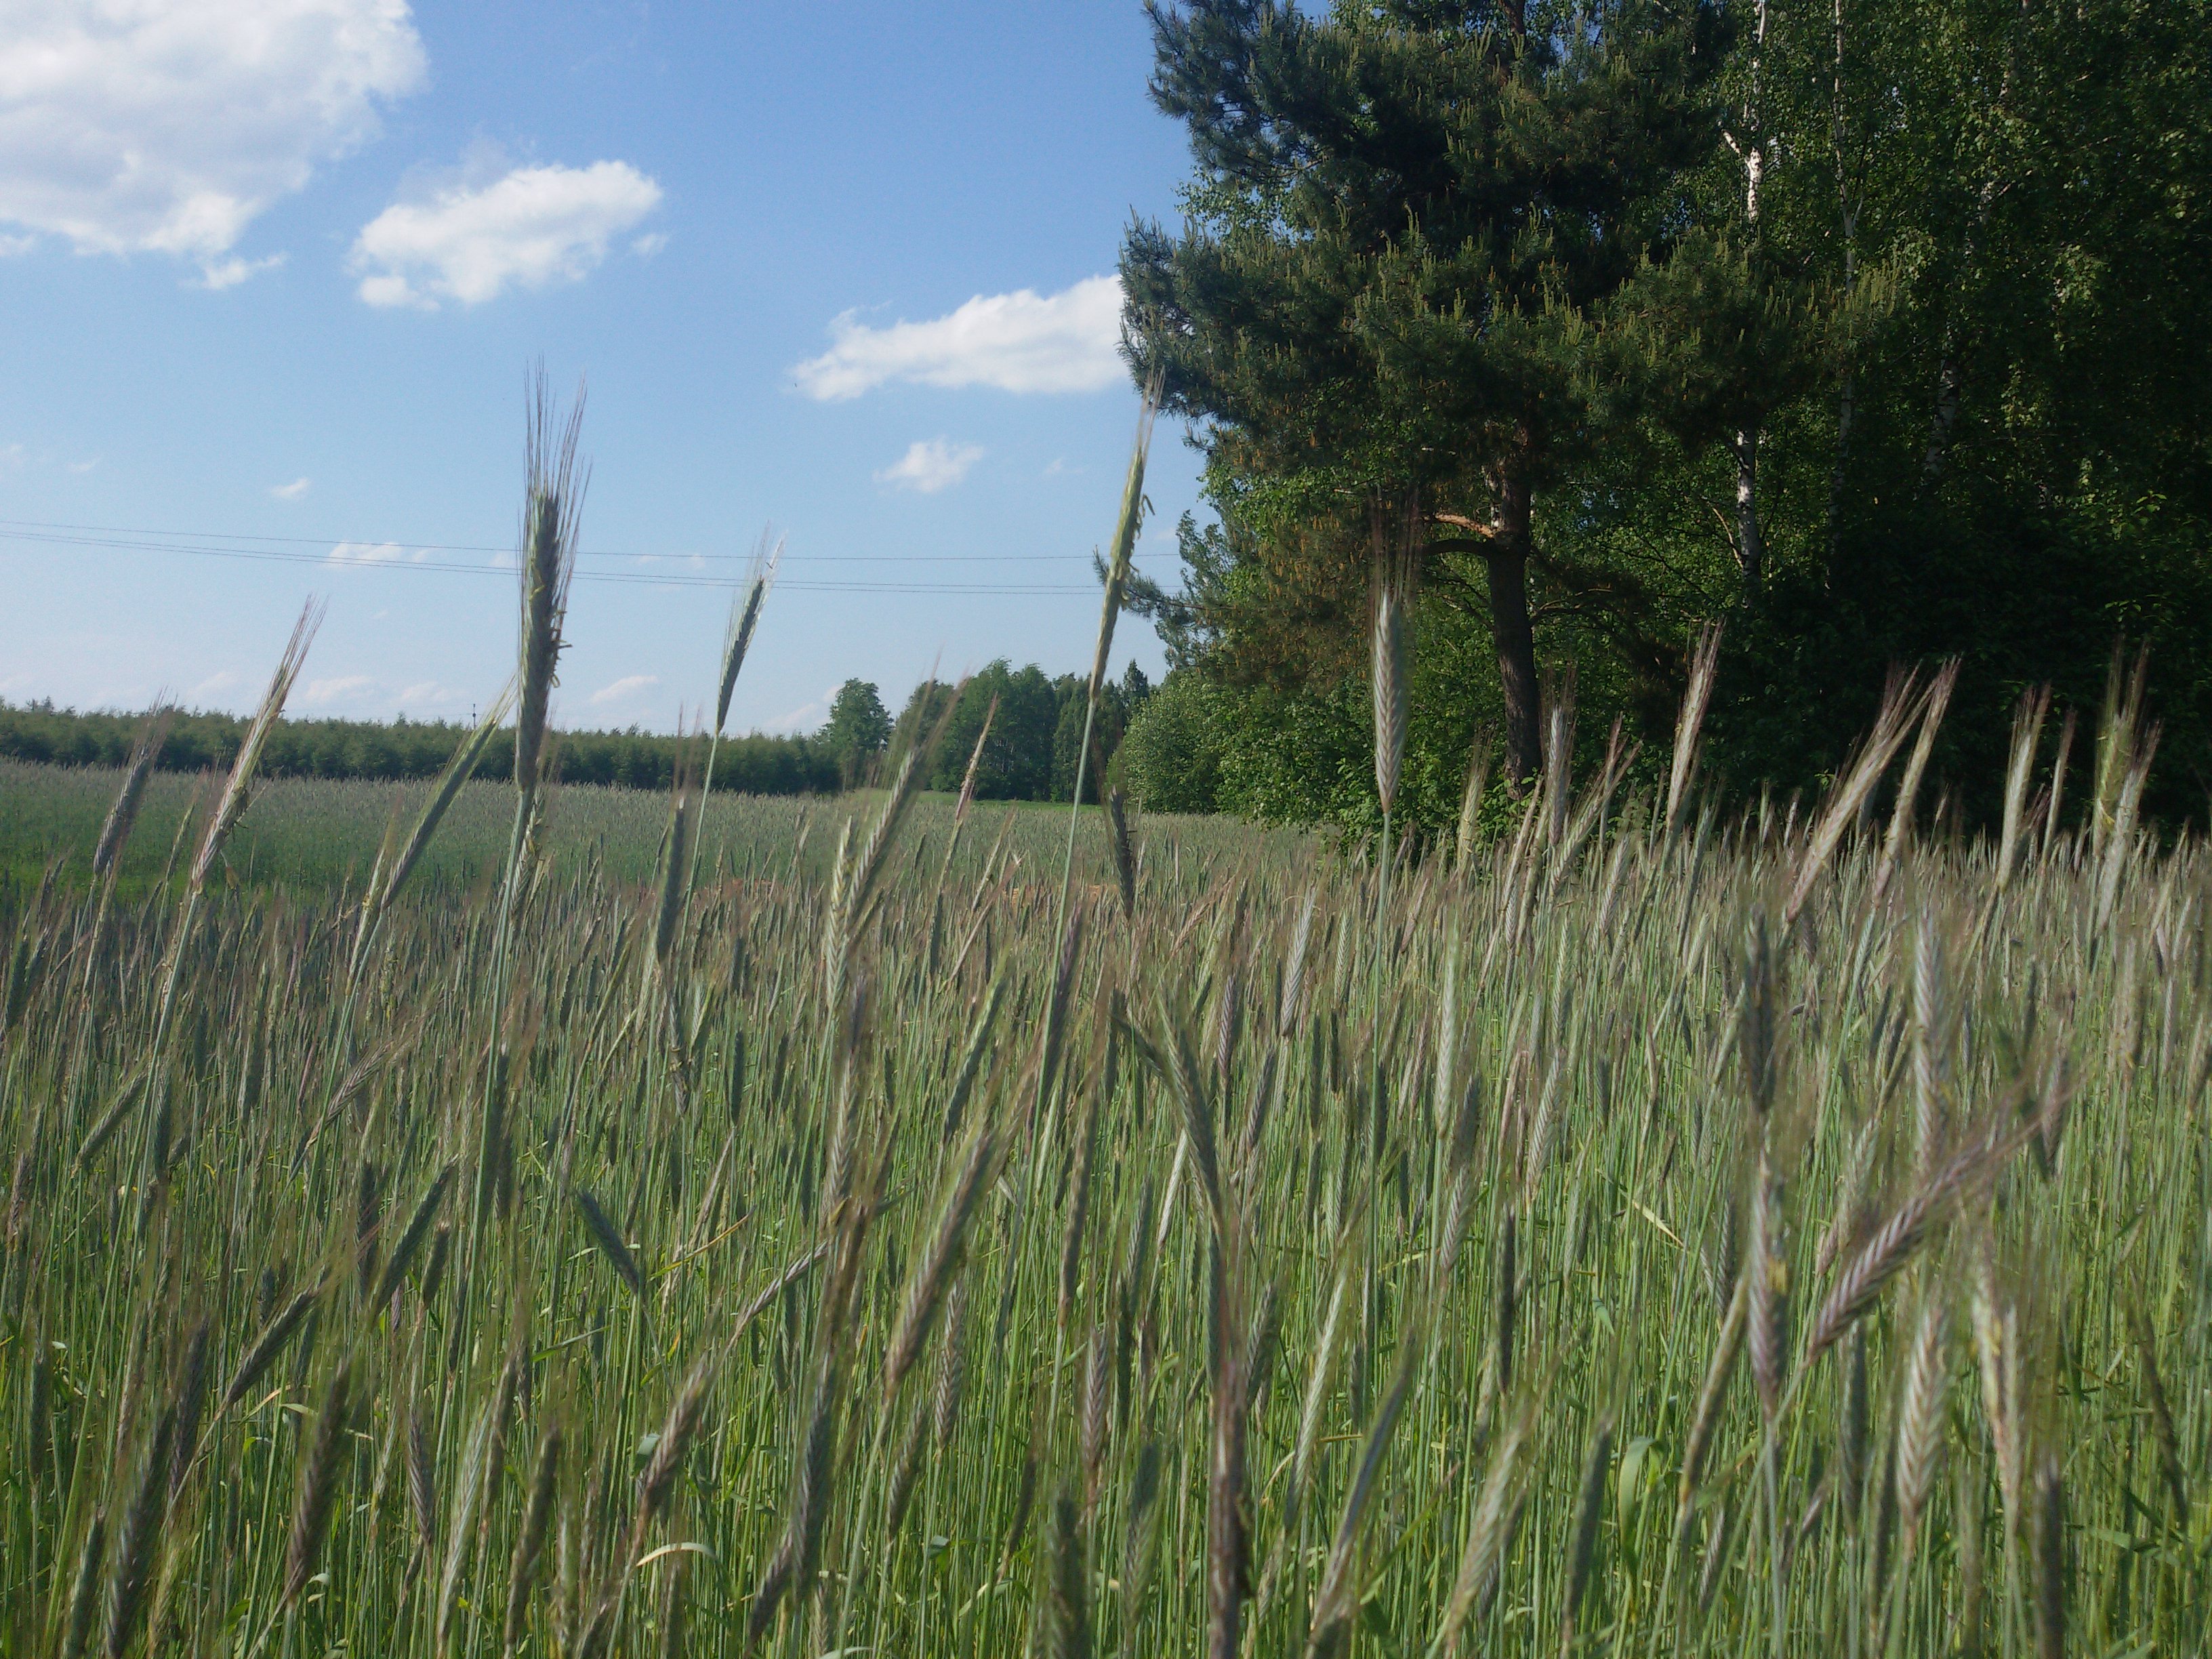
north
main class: Cropland
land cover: Rye
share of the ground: > 75 %
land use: Agriculture (excluding fallow land and kitchen gardens)
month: February
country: PL
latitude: 53.4266
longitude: 23.4926
